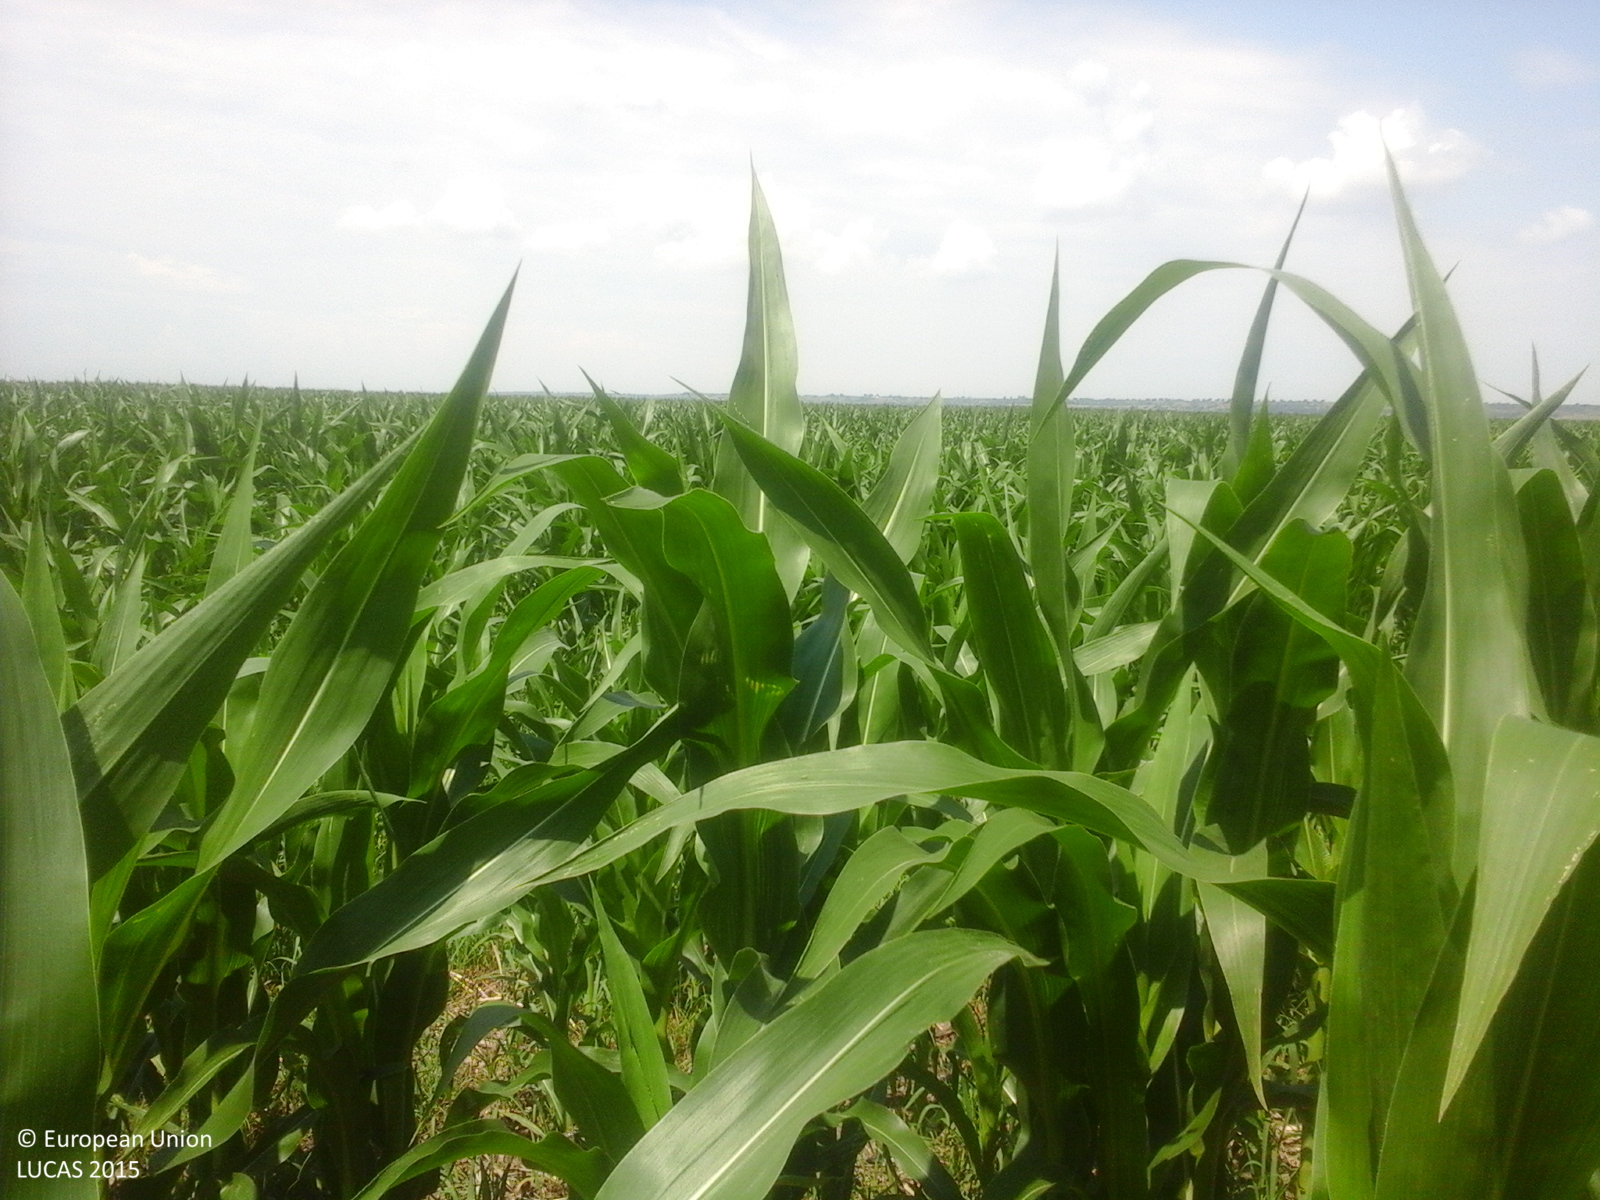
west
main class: Cropland
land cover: Maize
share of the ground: > 75 %
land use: Agriculture (excluding fallow land and kitchen gardens)
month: June
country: RO
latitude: 44.0951
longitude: 26.4352
